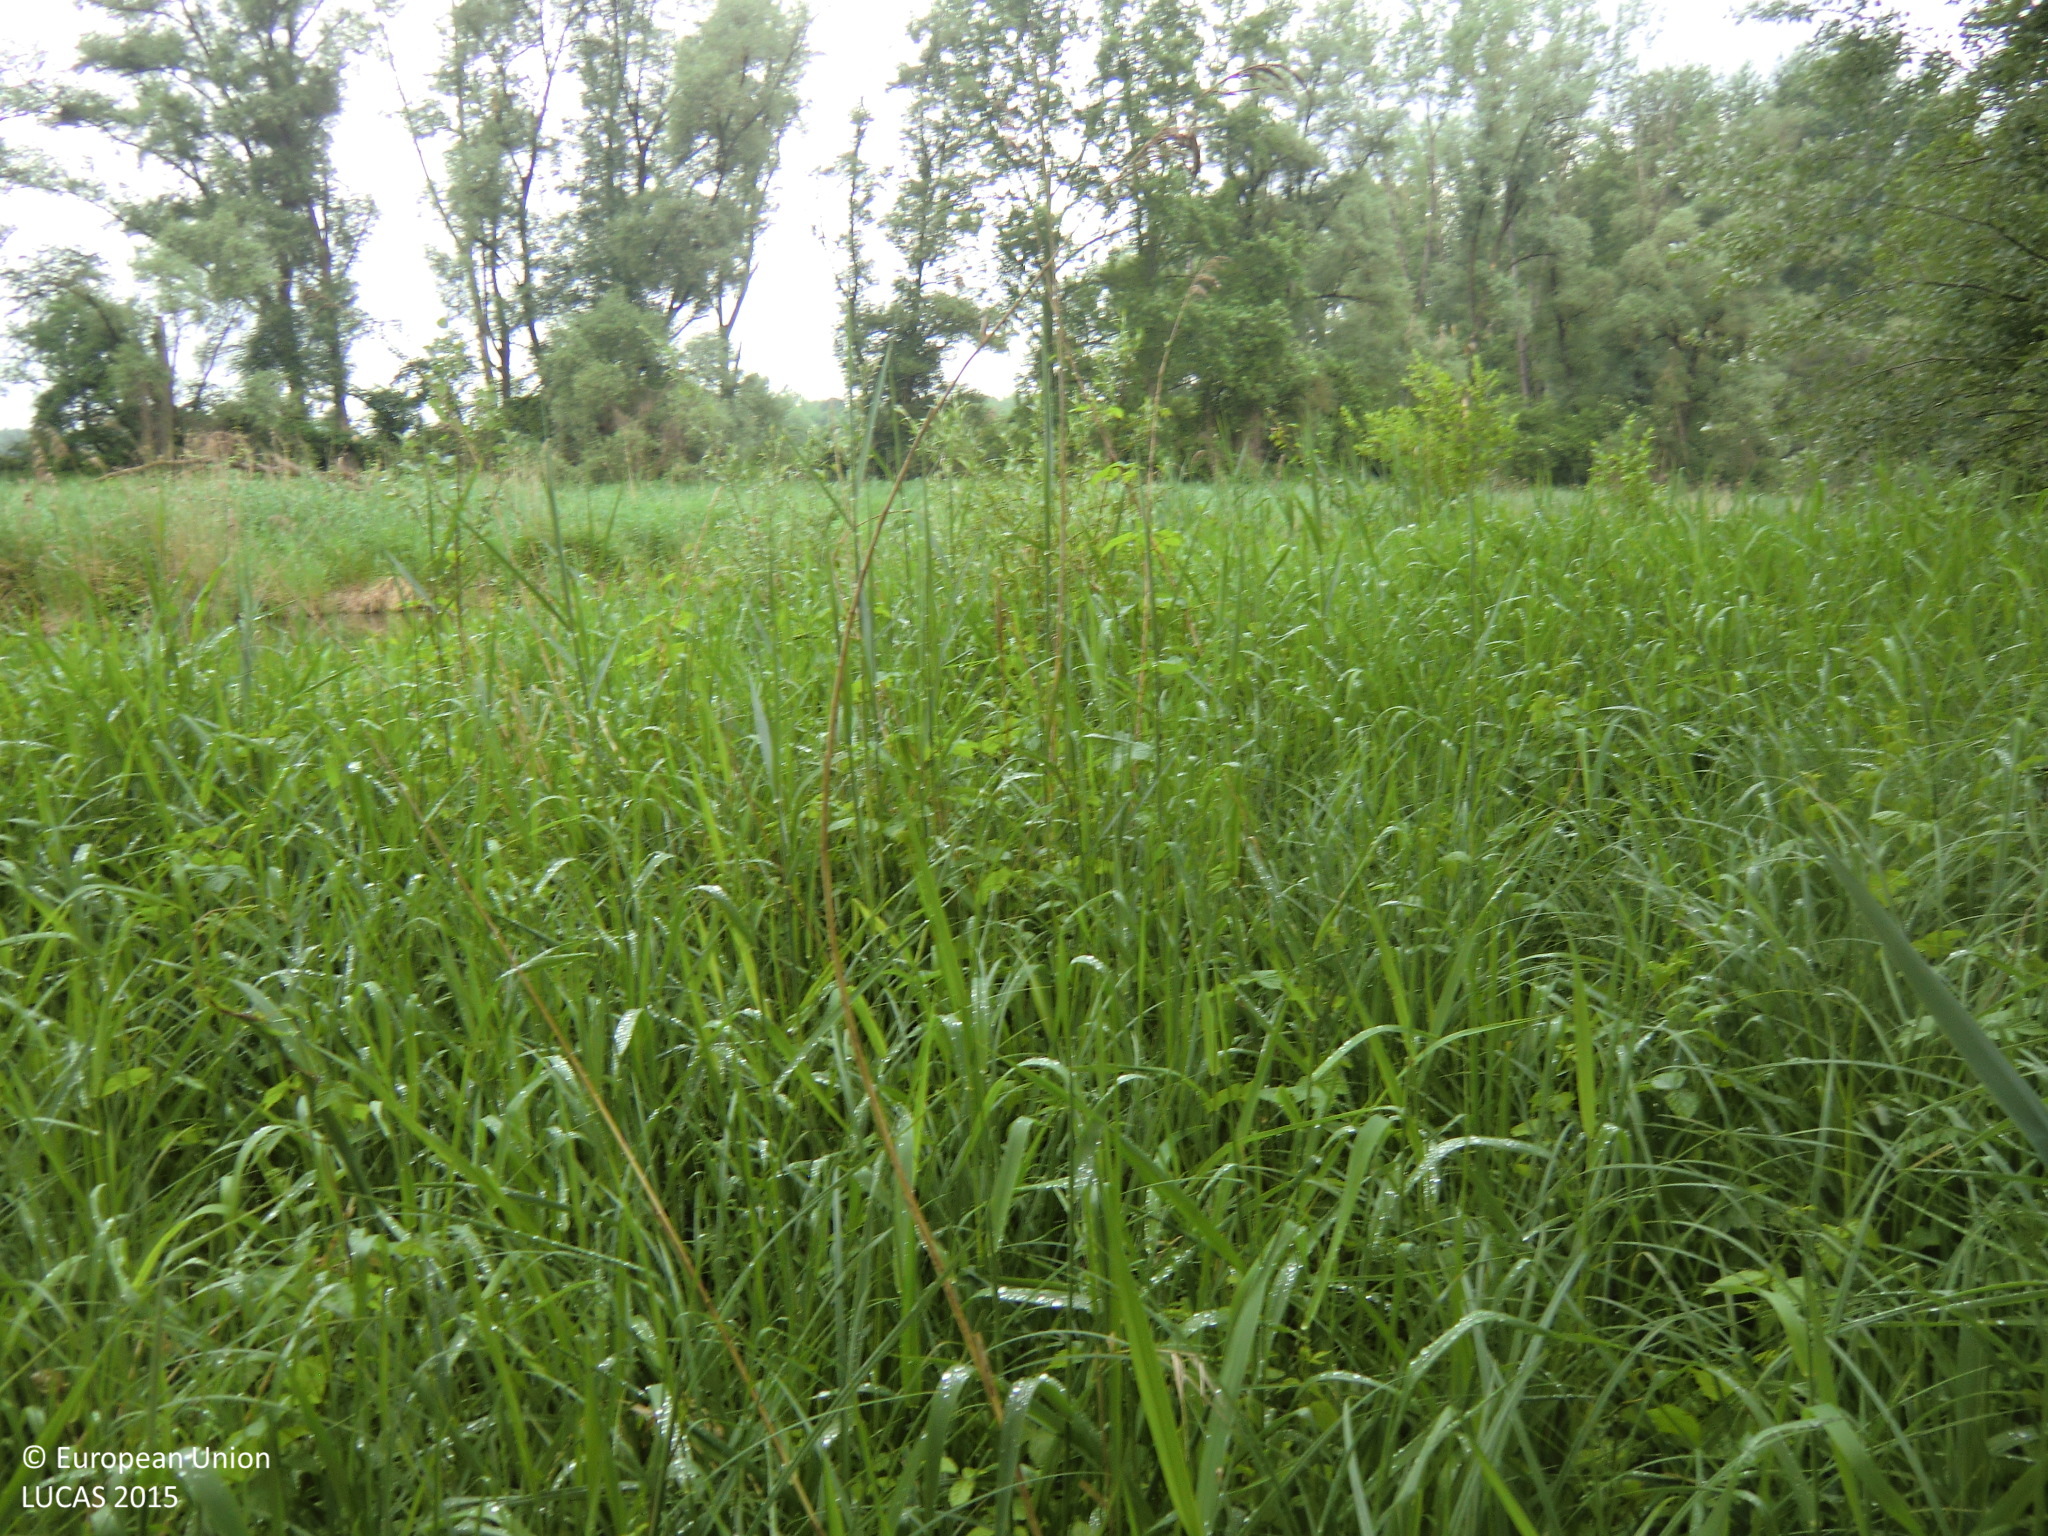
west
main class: Grassland
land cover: Grassland with sparse tree/shrub cover
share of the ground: > 75 %
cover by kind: herbaceous plants 95 %, broadleaved forest trees 5 %
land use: Semi-natural and natural areas not in use
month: May
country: AT
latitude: 48.2617
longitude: 14.4052
